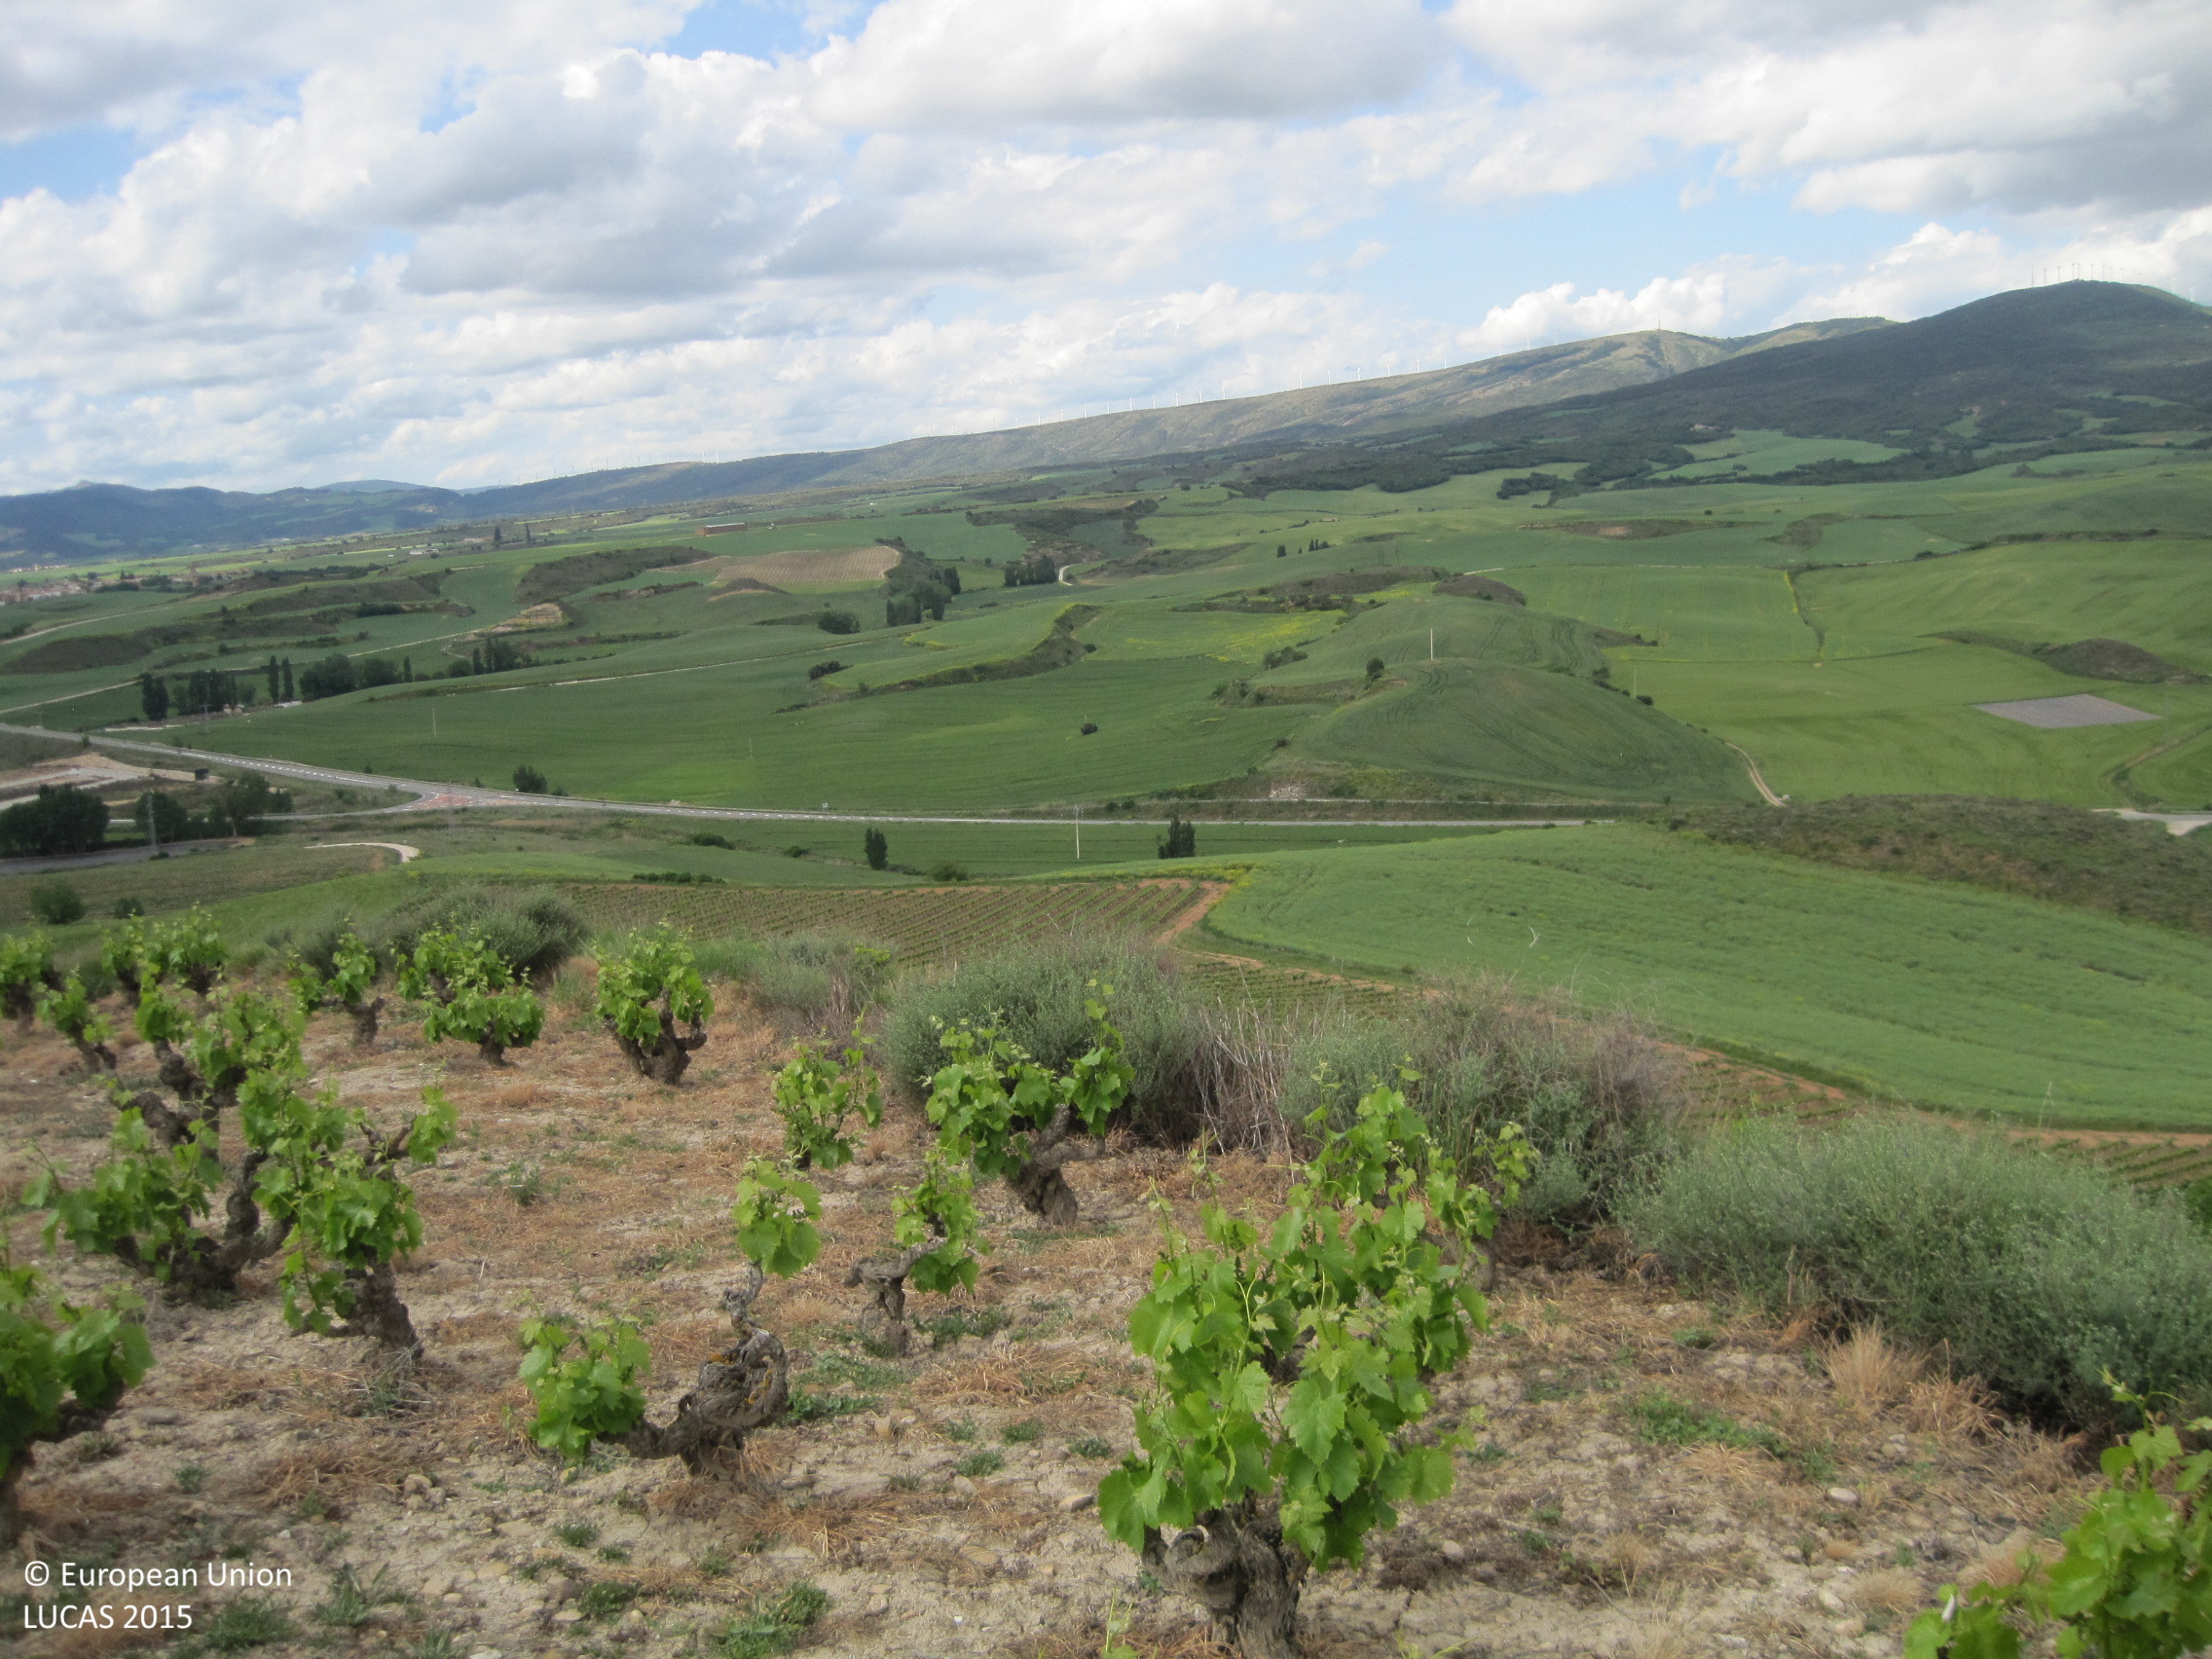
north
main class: Cropland
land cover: Vineyards
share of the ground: 10 - 25 %
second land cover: Other bare soil
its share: > 75 %
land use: Agriculture (excluding fallow land and kitchen gardens)
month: May
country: ES
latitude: 42.6645
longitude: -1.7144
